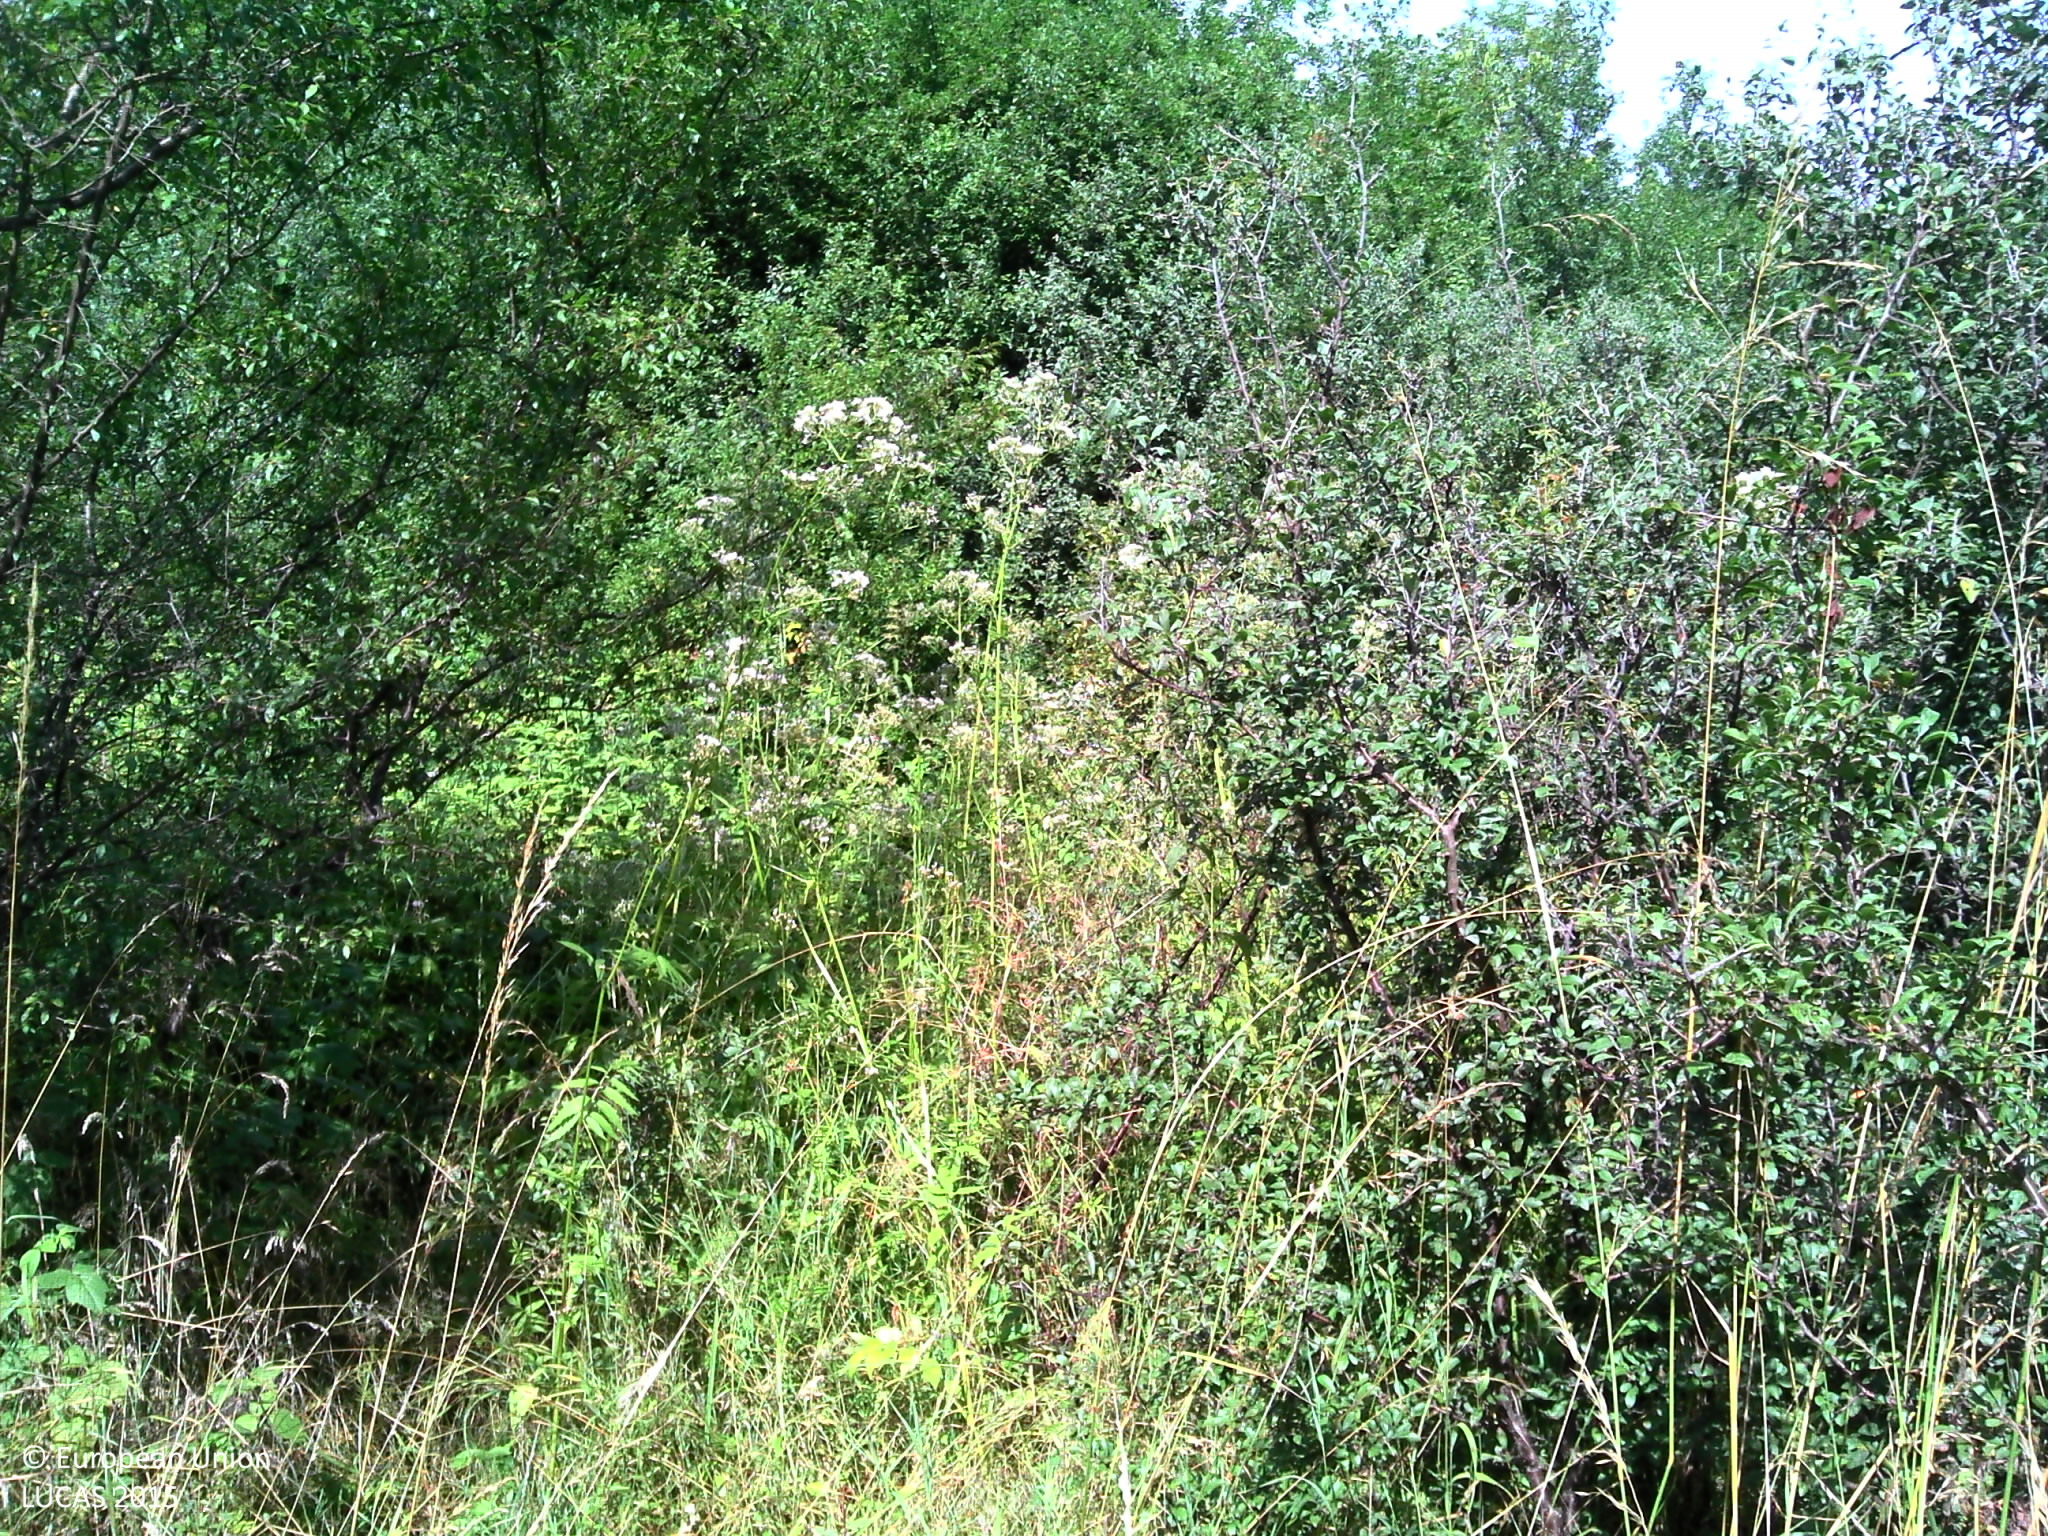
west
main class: Shrubland
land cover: Shrubland with sparse tree cover
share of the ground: 50 - 75 %
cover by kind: shrubs 60 %, herbaceous plants 35 %, broadleaved forest trees 5 %
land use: Forestry
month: July
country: BE
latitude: 49.7286
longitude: 5.7954
